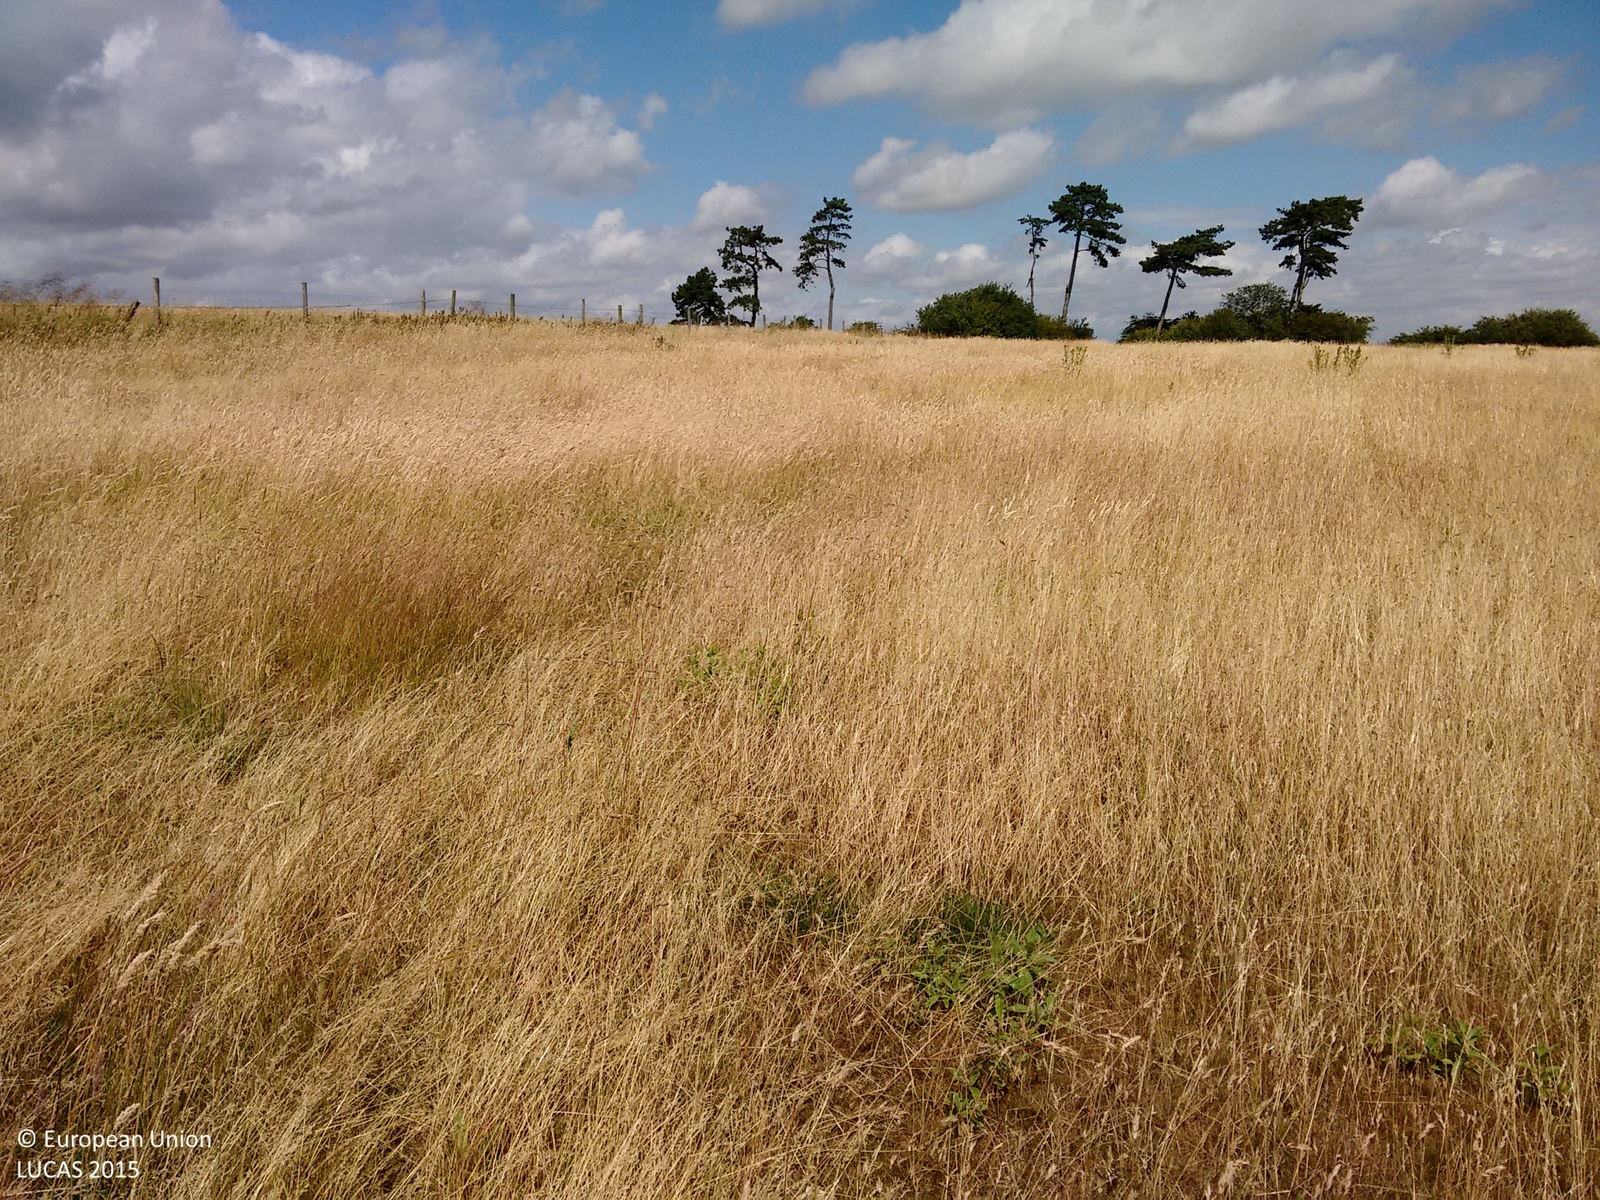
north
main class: Grassland
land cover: Grassland without tree/shrub cover
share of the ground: > 75 %
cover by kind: herbaceous plants 100 %
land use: Agriculture (excluding fallow land and kitchen gardens)
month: July
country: GB
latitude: 52.6508
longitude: -0.9373
